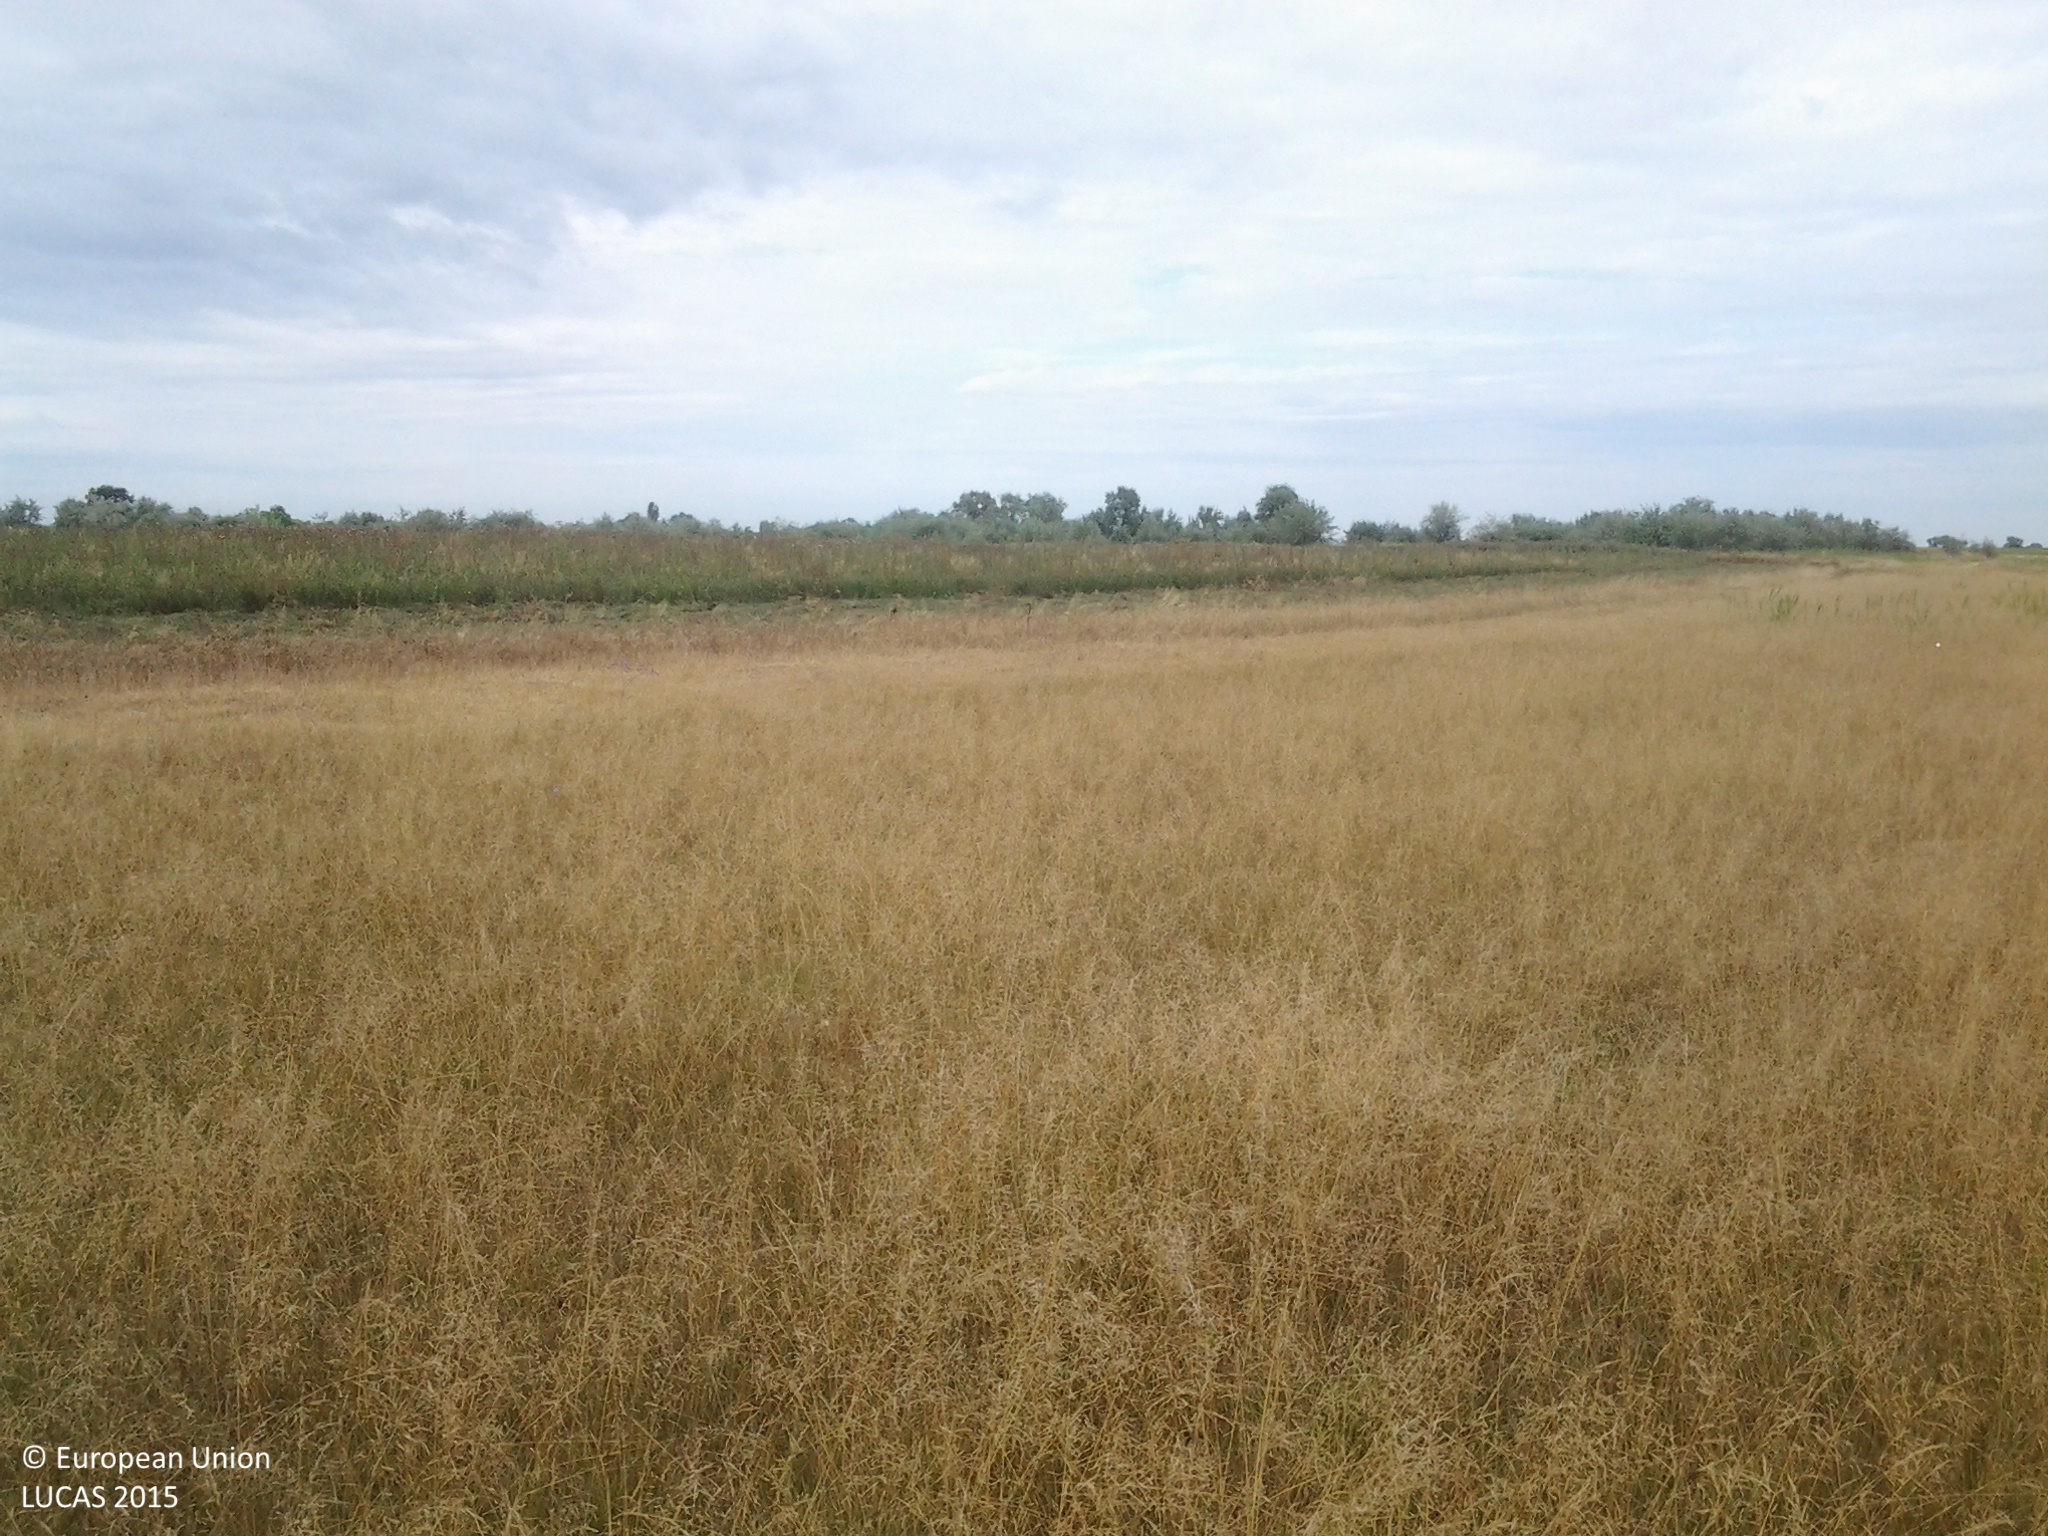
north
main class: Grassland
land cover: Grassland without tree/shrub cover
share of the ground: > 75 %
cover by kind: herbaceous plants 100 %
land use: Agriculture (excluding fallow land and kitchen gardens)
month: July
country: HU
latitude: 46.6850
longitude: 19.1283
